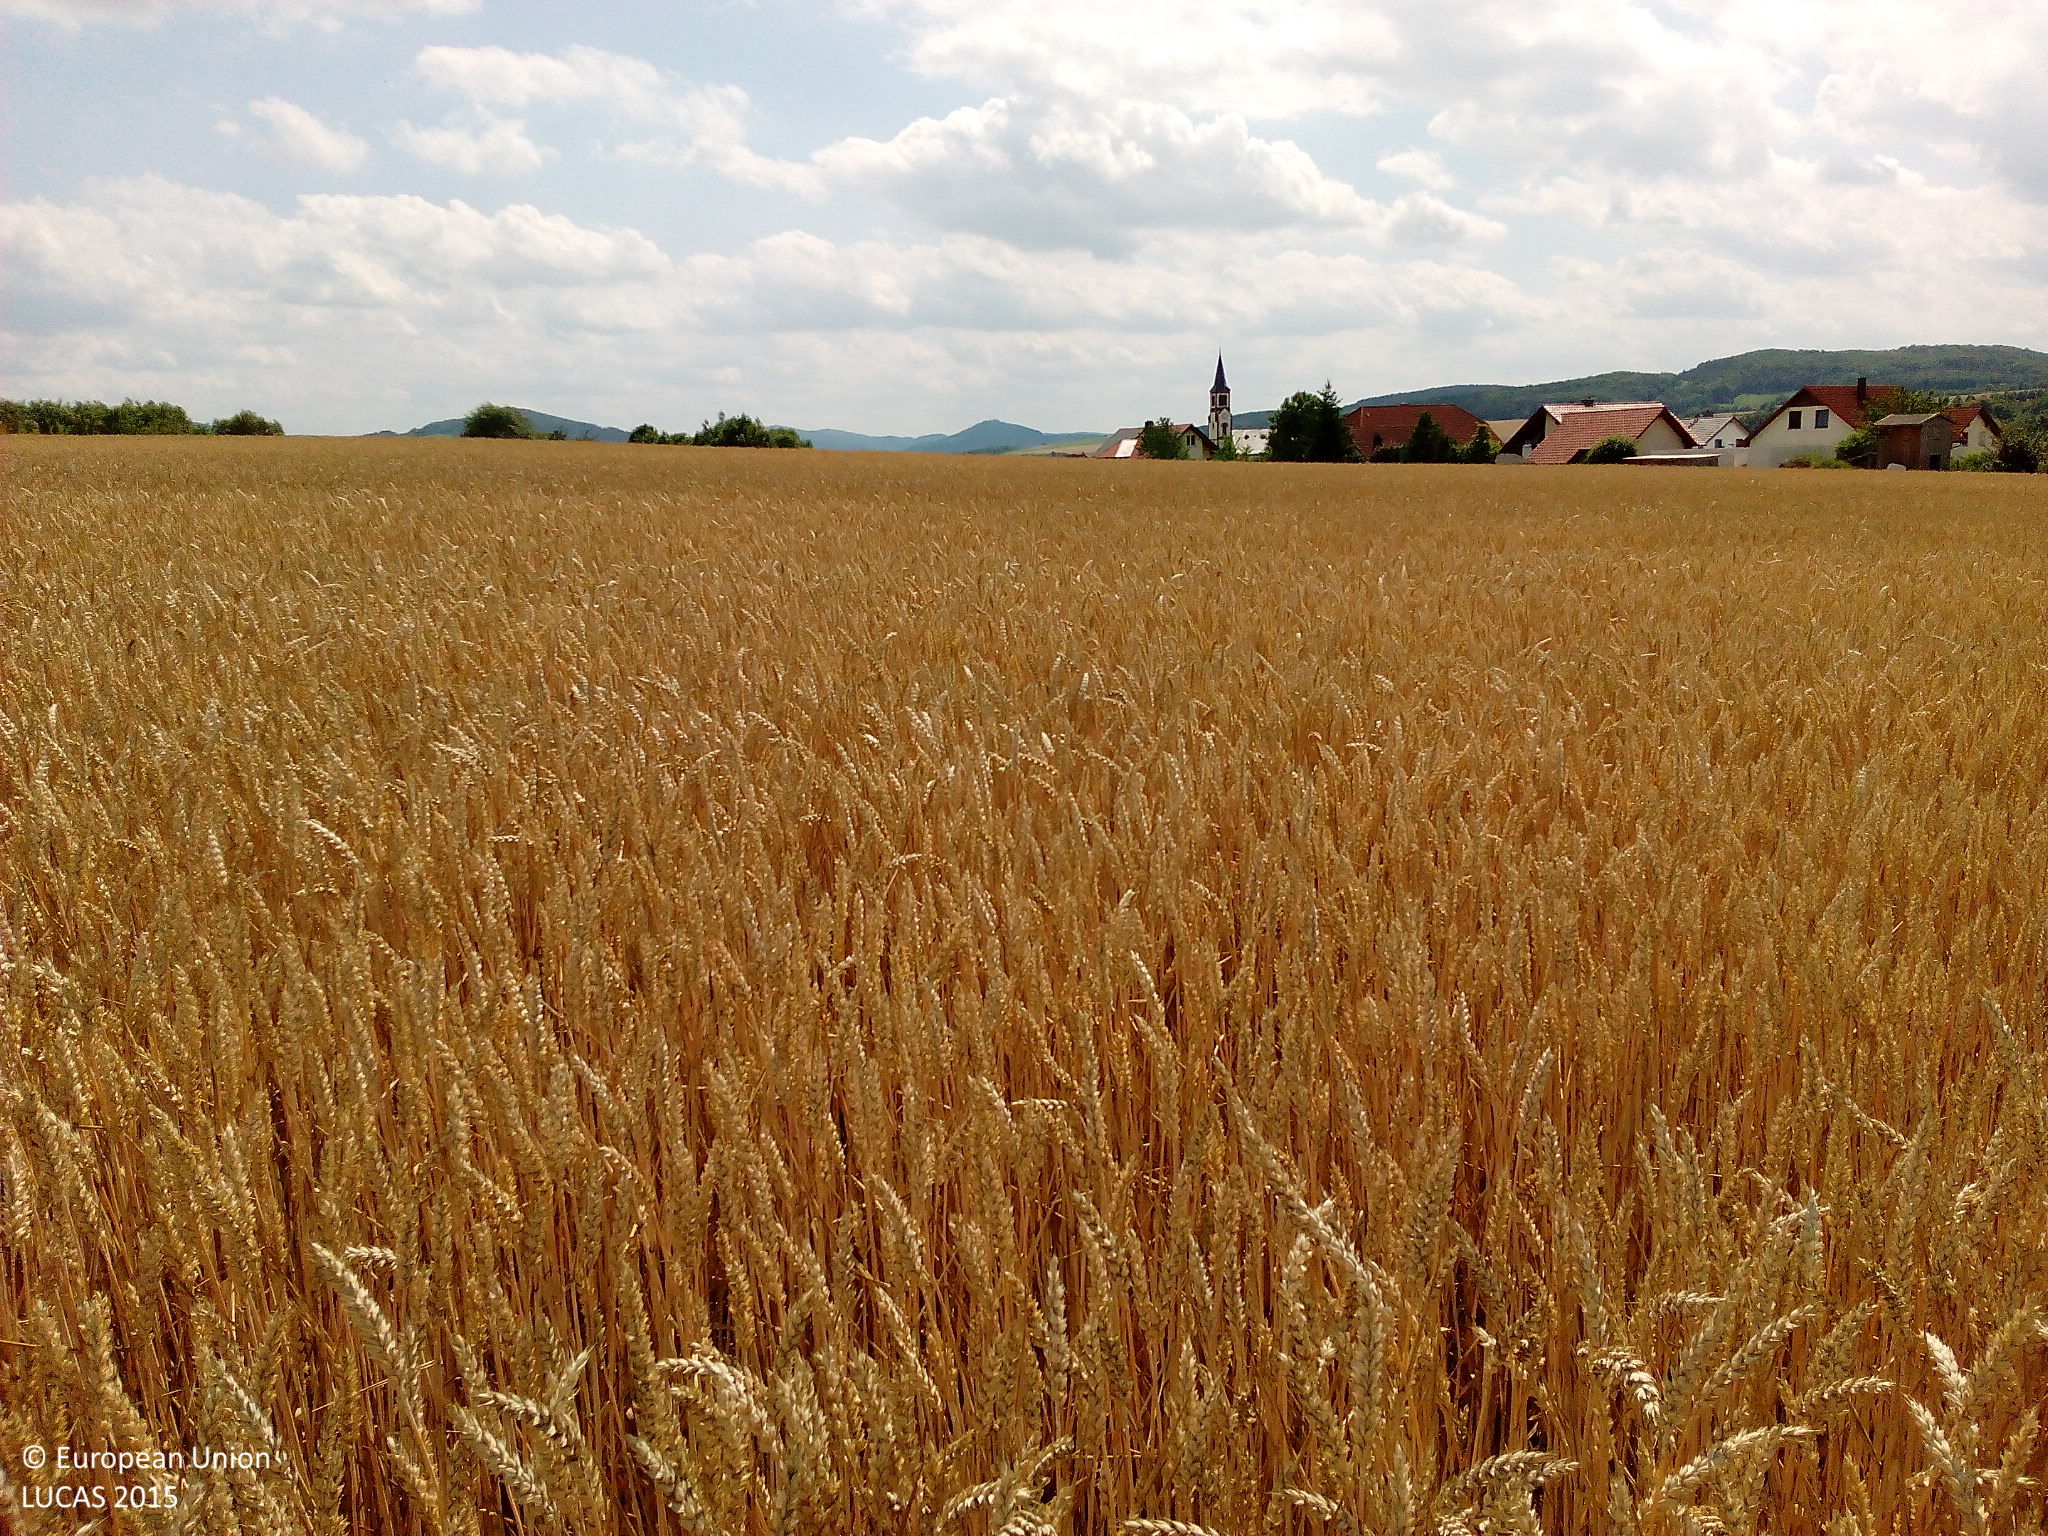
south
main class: Cropland
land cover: Common wheat
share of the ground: > 75 %
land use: Agriculture (excluding fallow land and kitchen gardens)
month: July
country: DE
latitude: 50.7596
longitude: 9.9575
